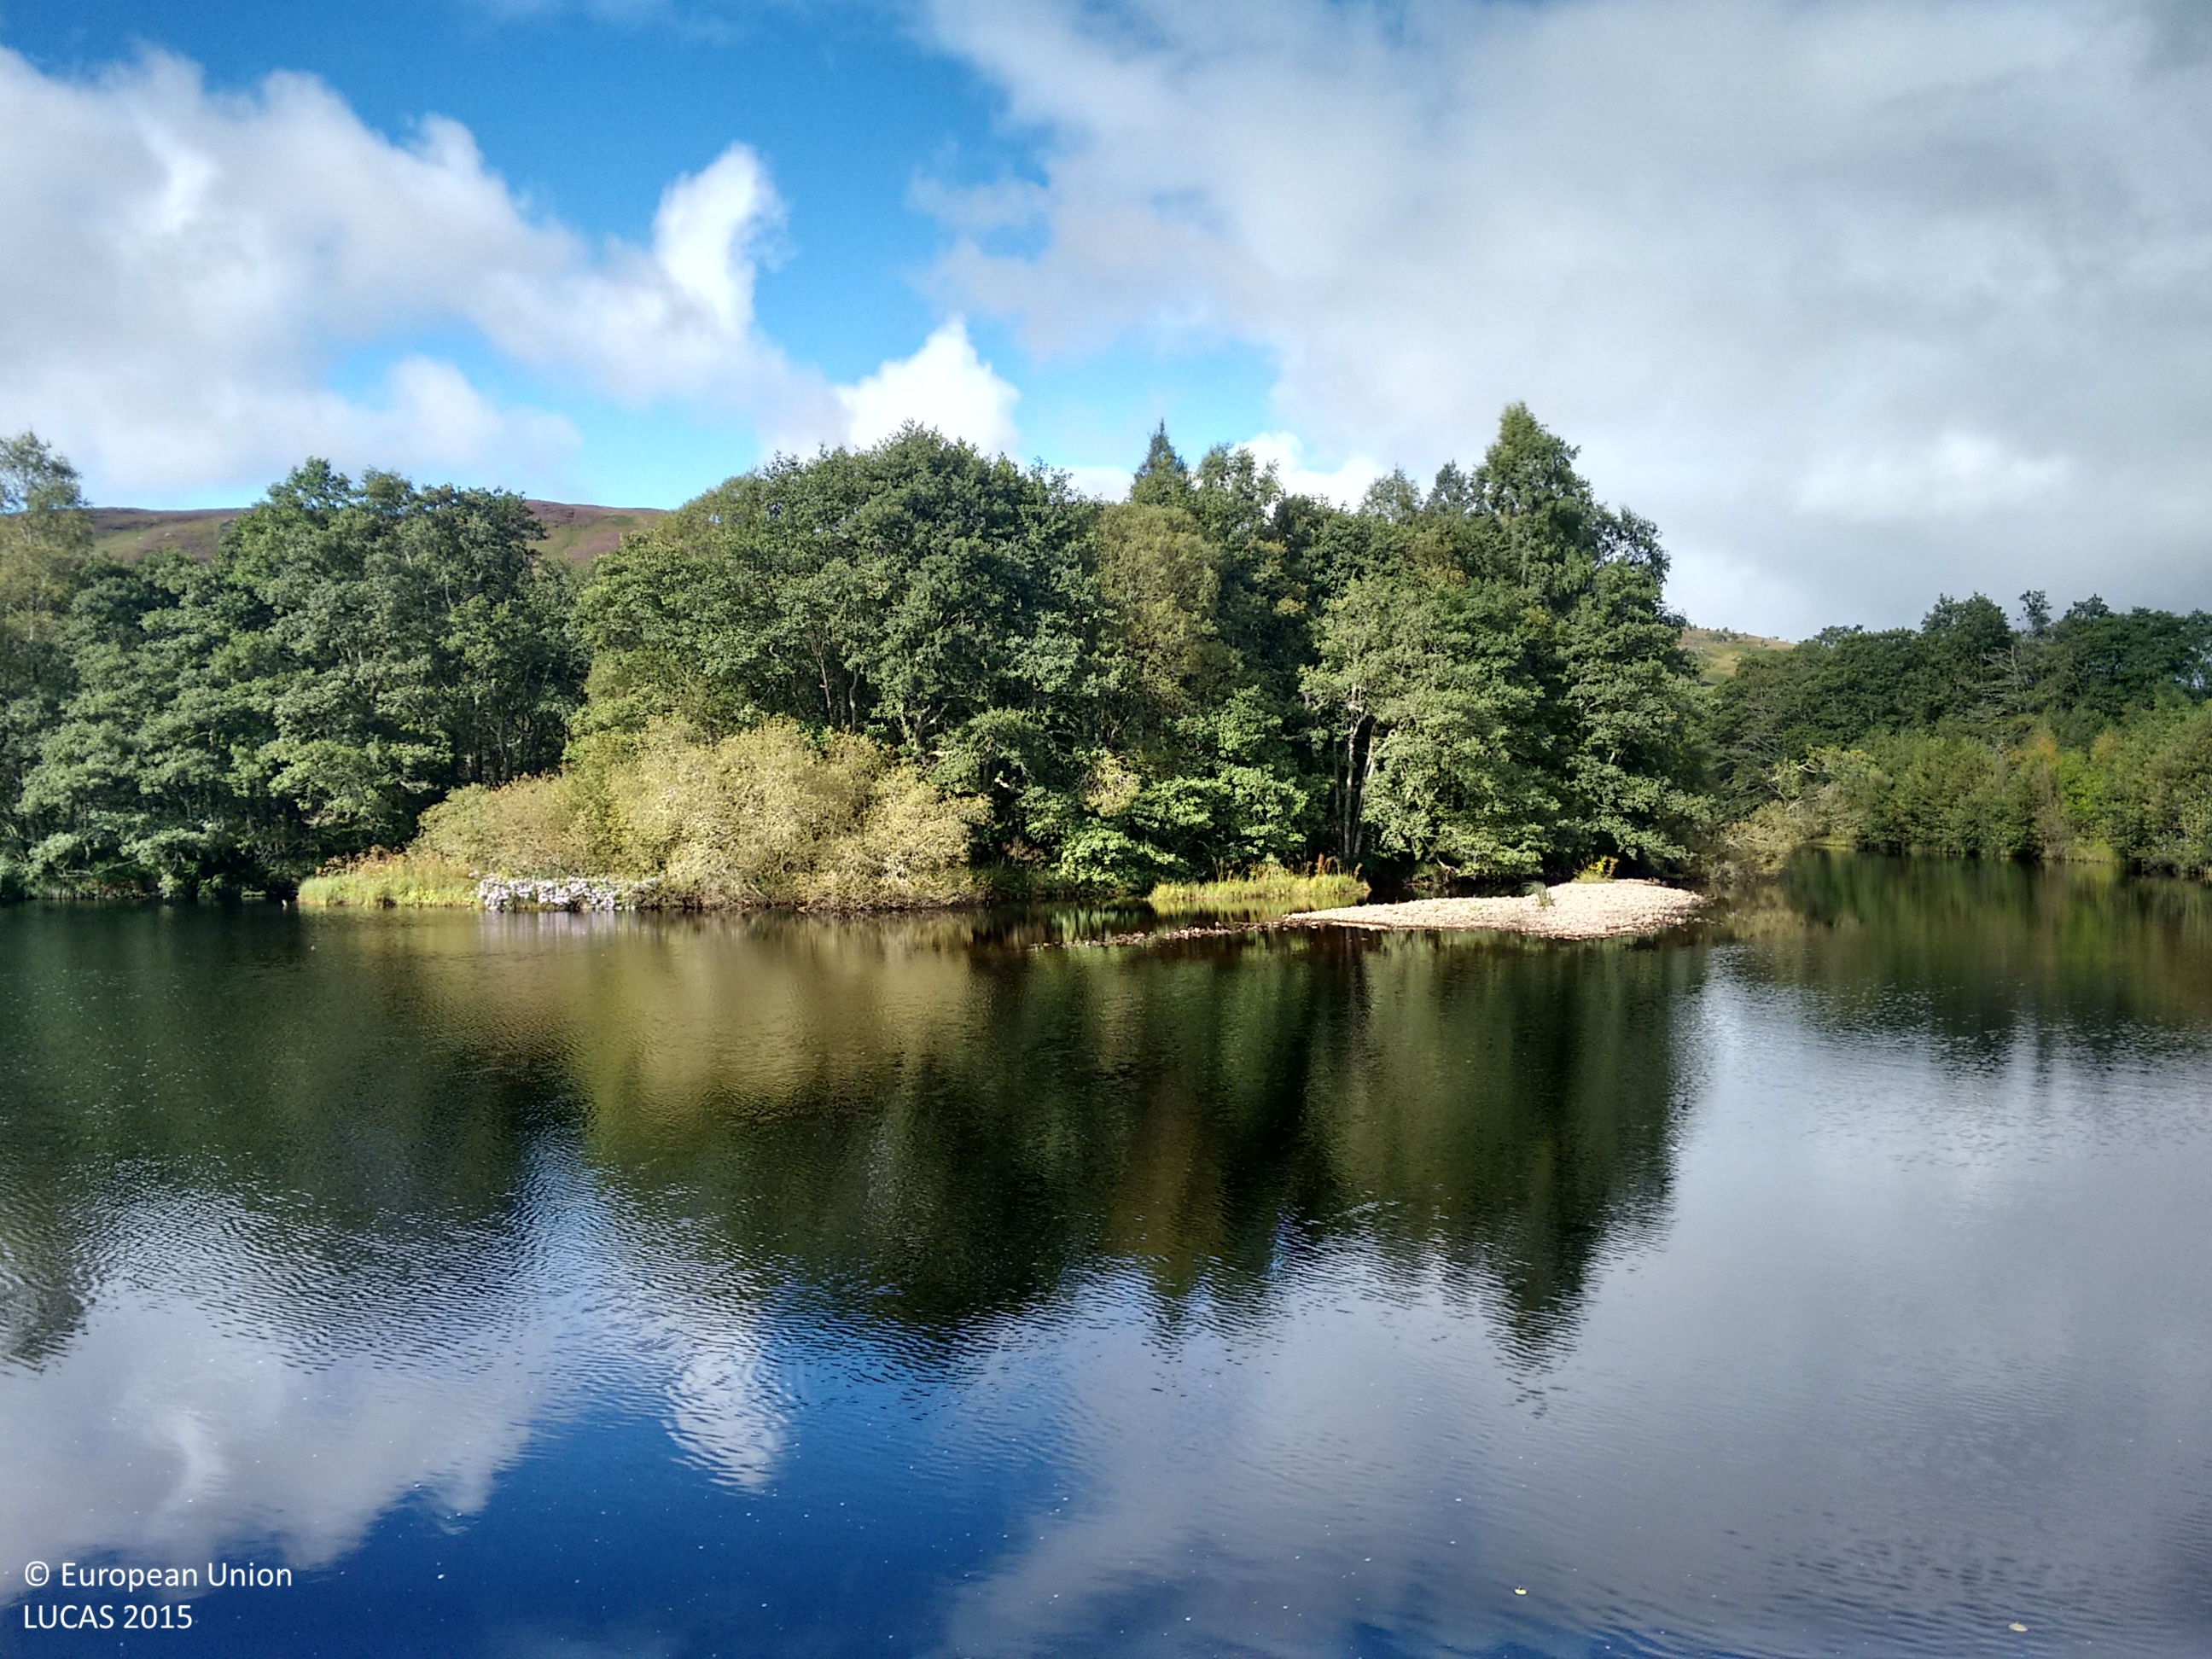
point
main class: Woodland
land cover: Broadleaved woodland
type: floodplain forest
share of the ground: > 75 %
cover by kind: broadleaved forest trees 100 %
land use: Semi-natural and natural areas not in use
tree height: > 5 m
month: September
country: GB
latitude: 57.6095
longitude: -4.6726
